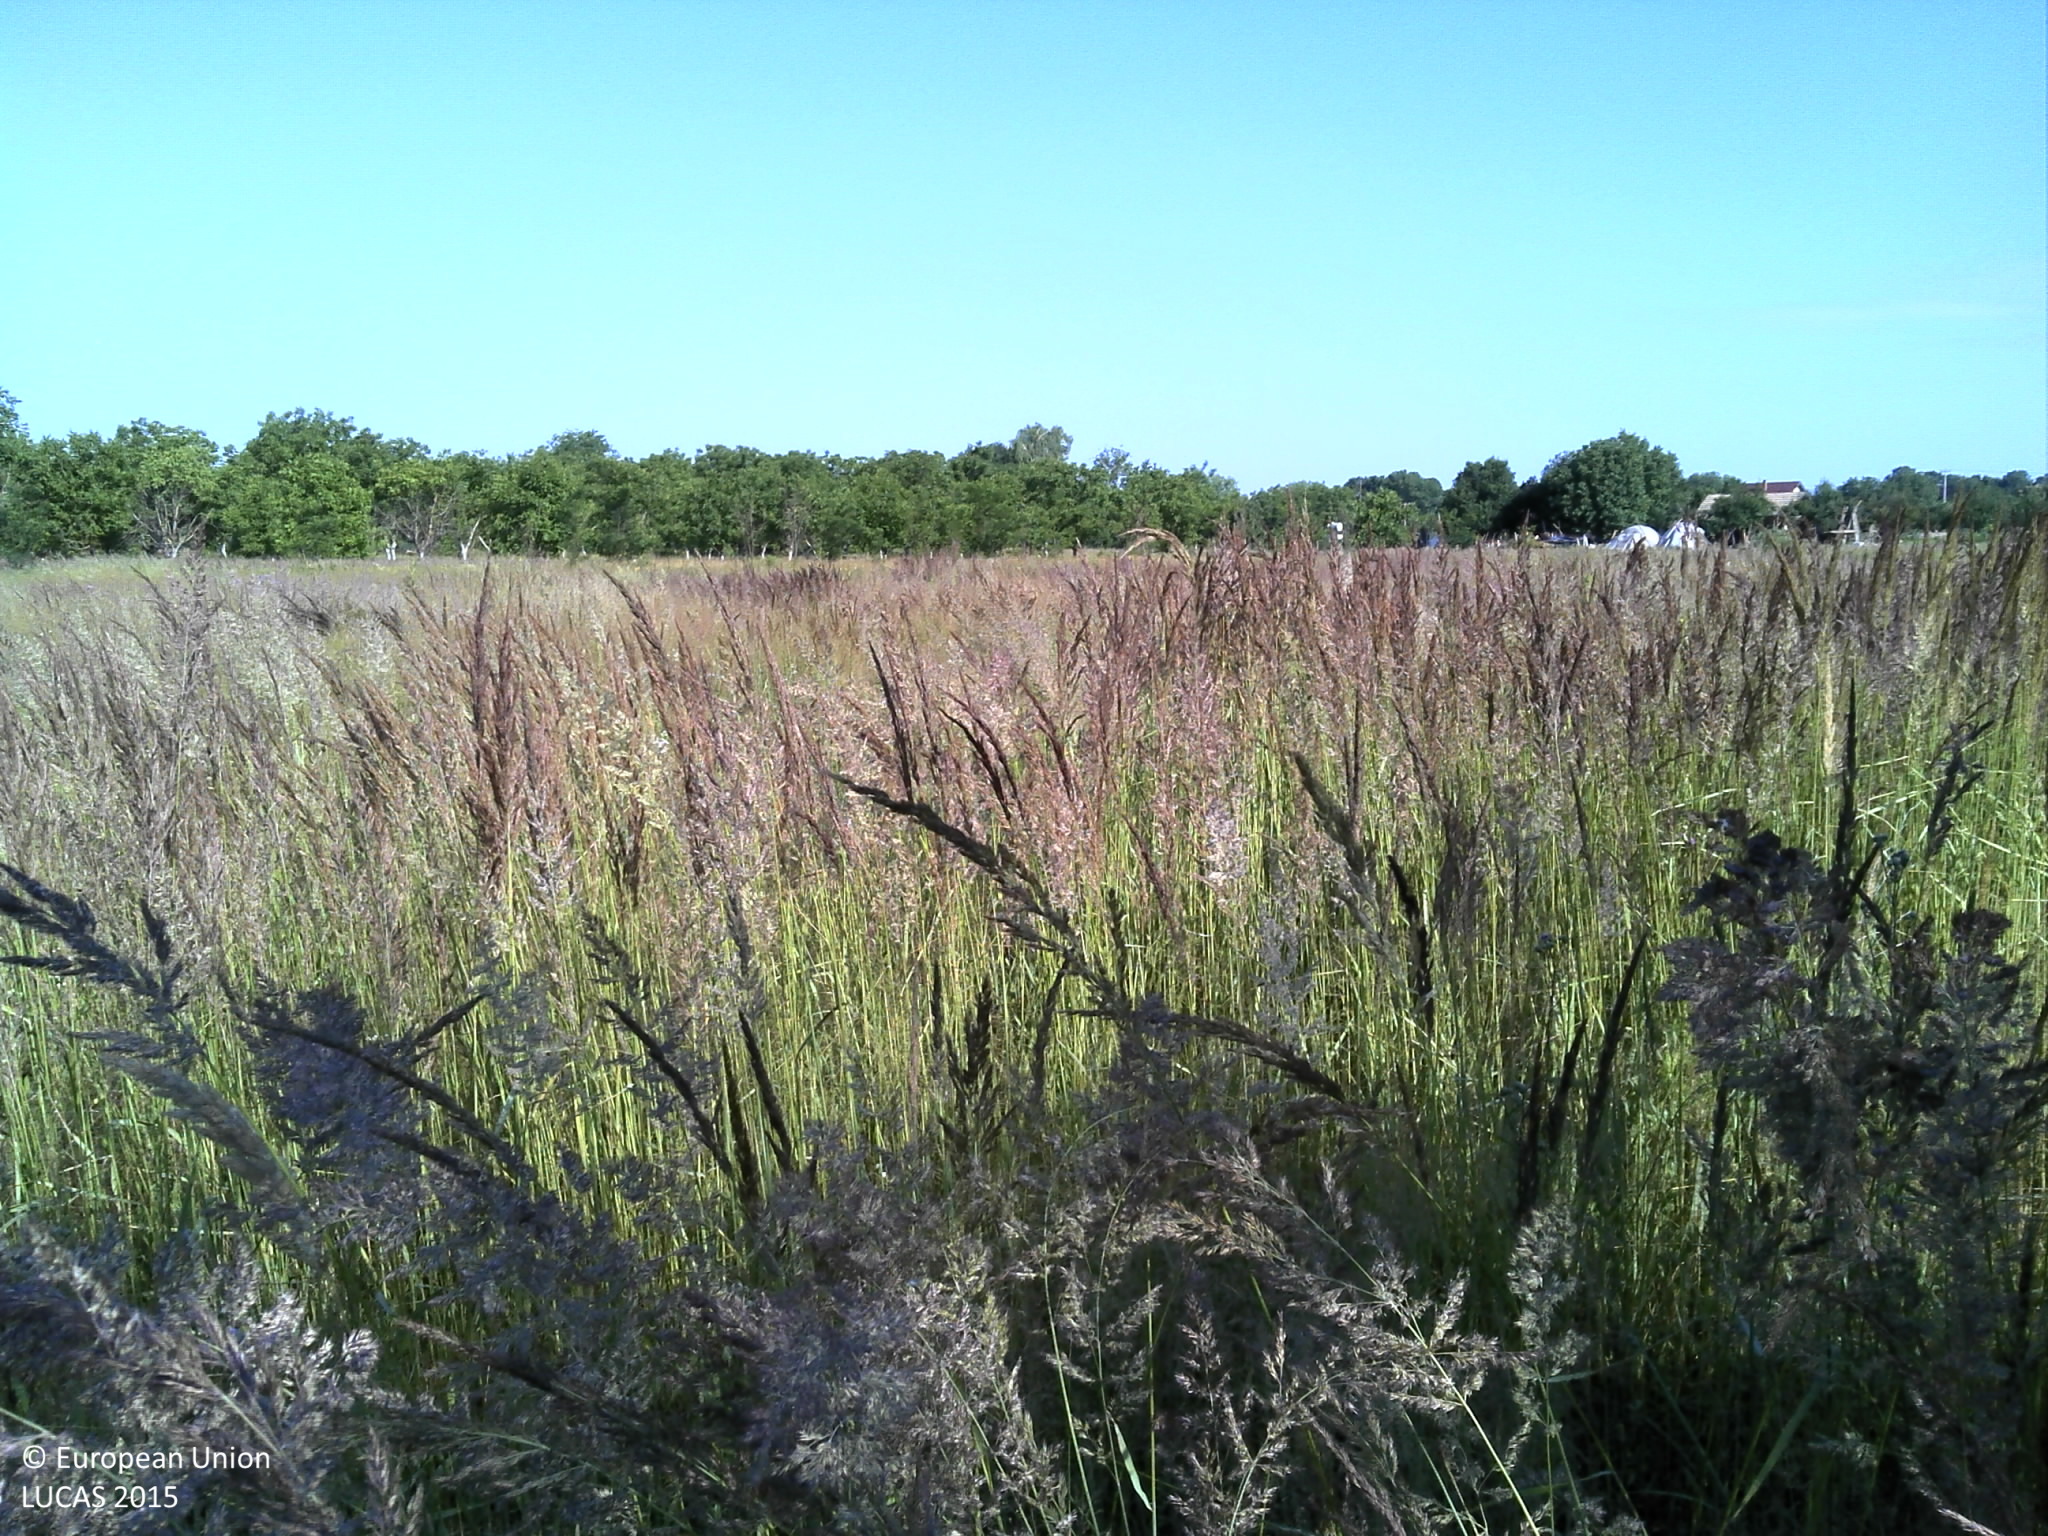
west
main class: Grassland
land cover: Grassland without tree/shrub cover
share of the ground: > 75 %
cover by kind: herbaceous plants 100 %
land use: Semi-natural and natural areas not in use
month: June
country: HR
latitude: 45.6174
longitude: 18.4579
